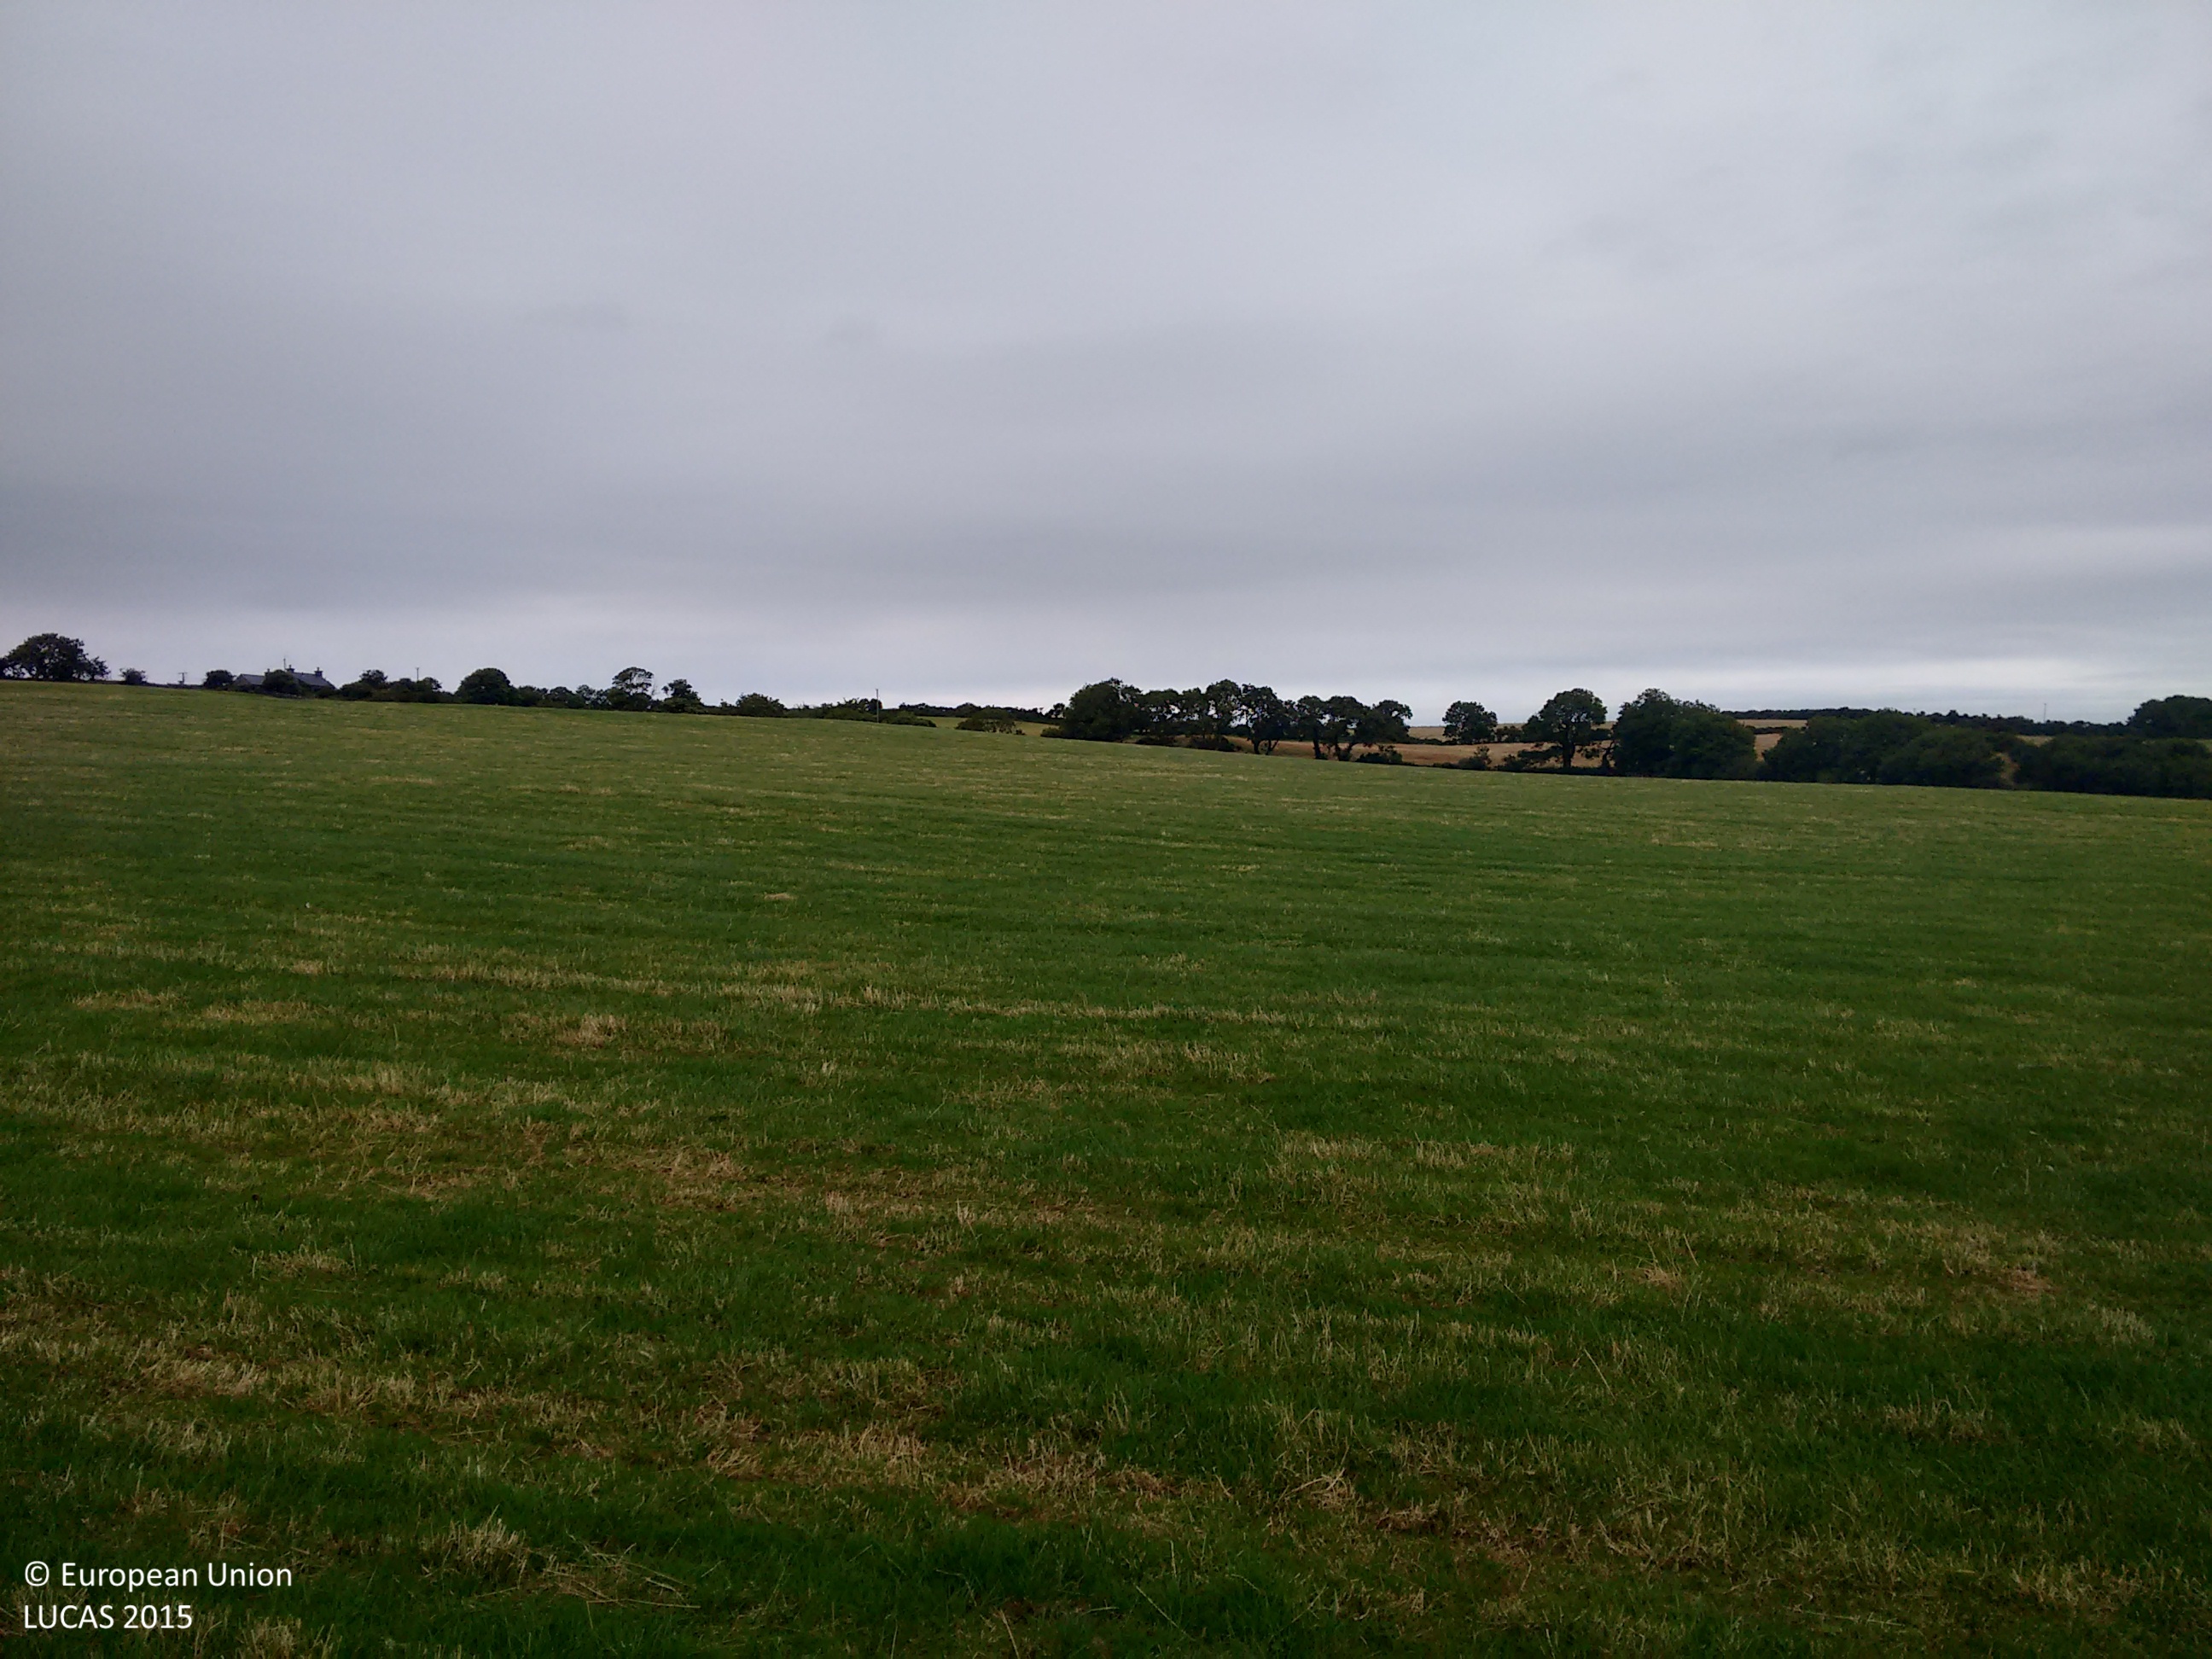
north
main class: Grassland
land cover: Grassland without tree/shrub cover
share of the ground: > 75 %
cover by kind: herbaceous plants 100 %
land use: Agriculture (excluding fallow land and kitchen gardens)
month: August
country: GB
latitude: 53.2953
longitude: -4.4622
